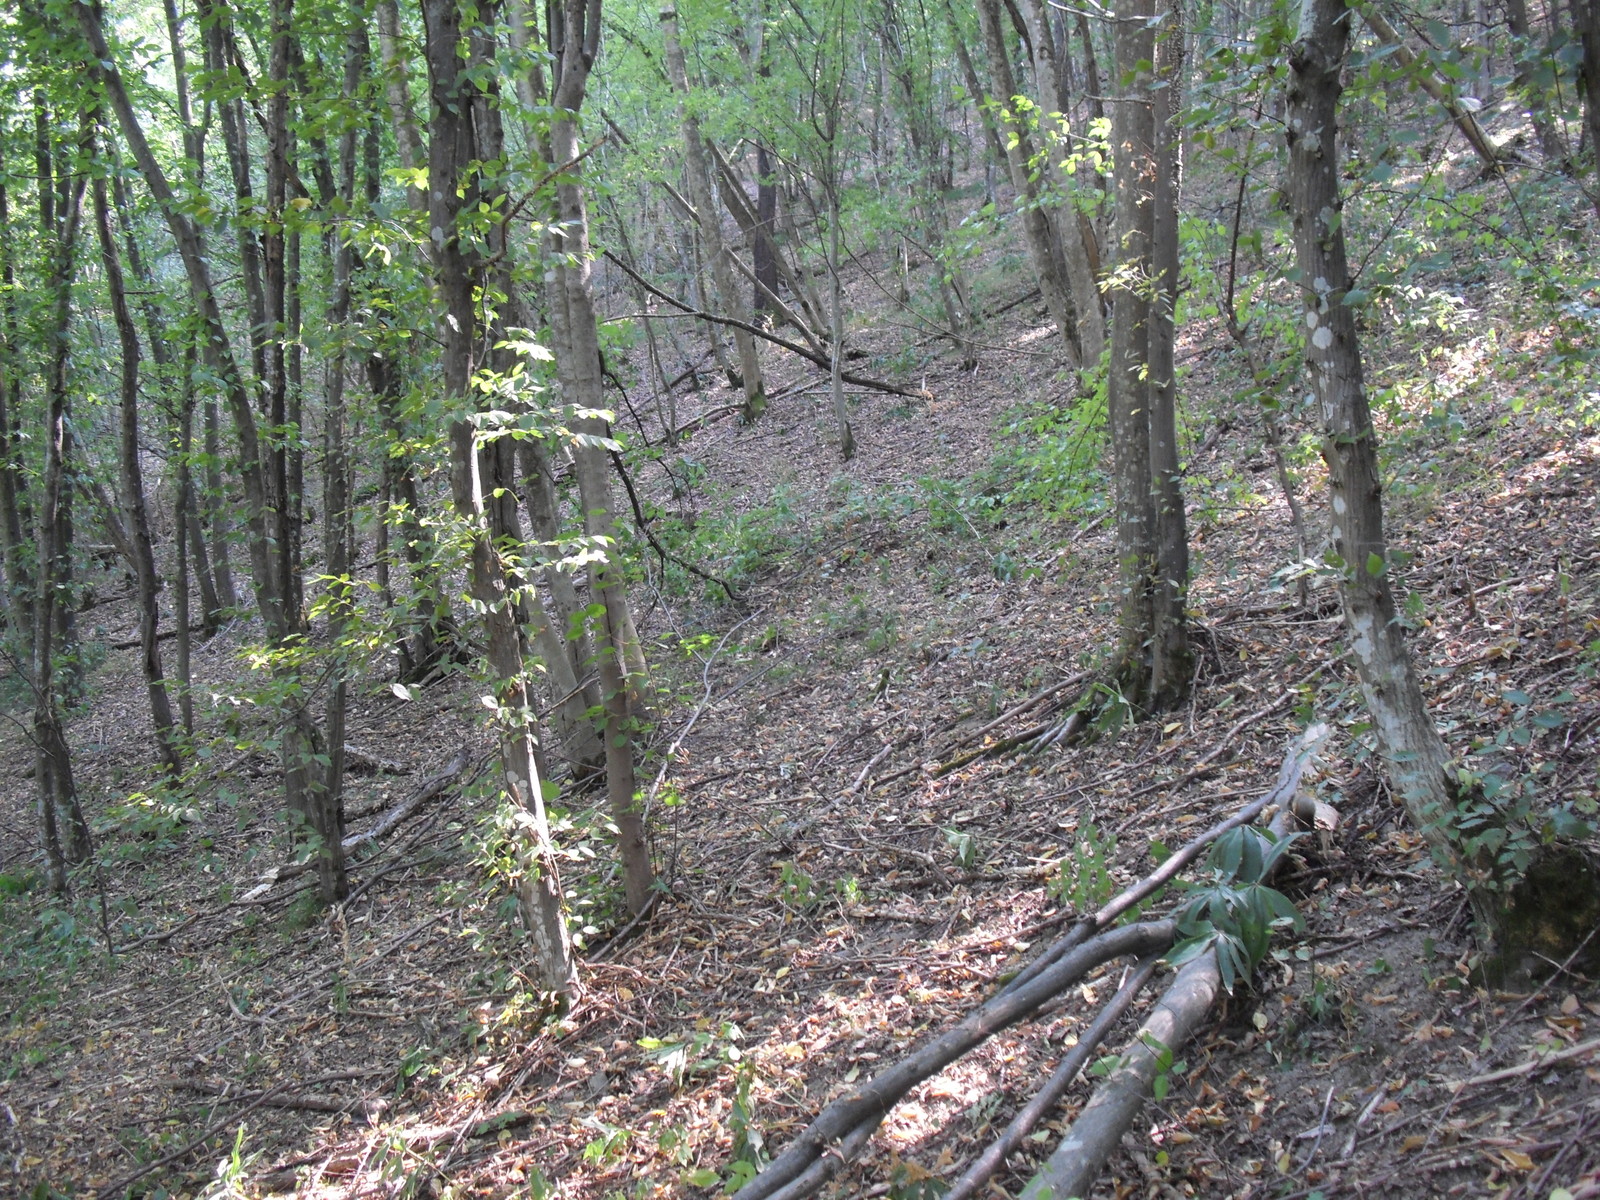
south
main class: Woodland
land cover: Broadleaved woodland
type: beech forest
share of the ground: > 75 %
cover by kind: broadleaved forest trees 95 %, shrubs 5 %
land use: Forestry
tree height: > 5 m
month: August
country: BG
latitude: 43.2679
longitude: 23.1836
